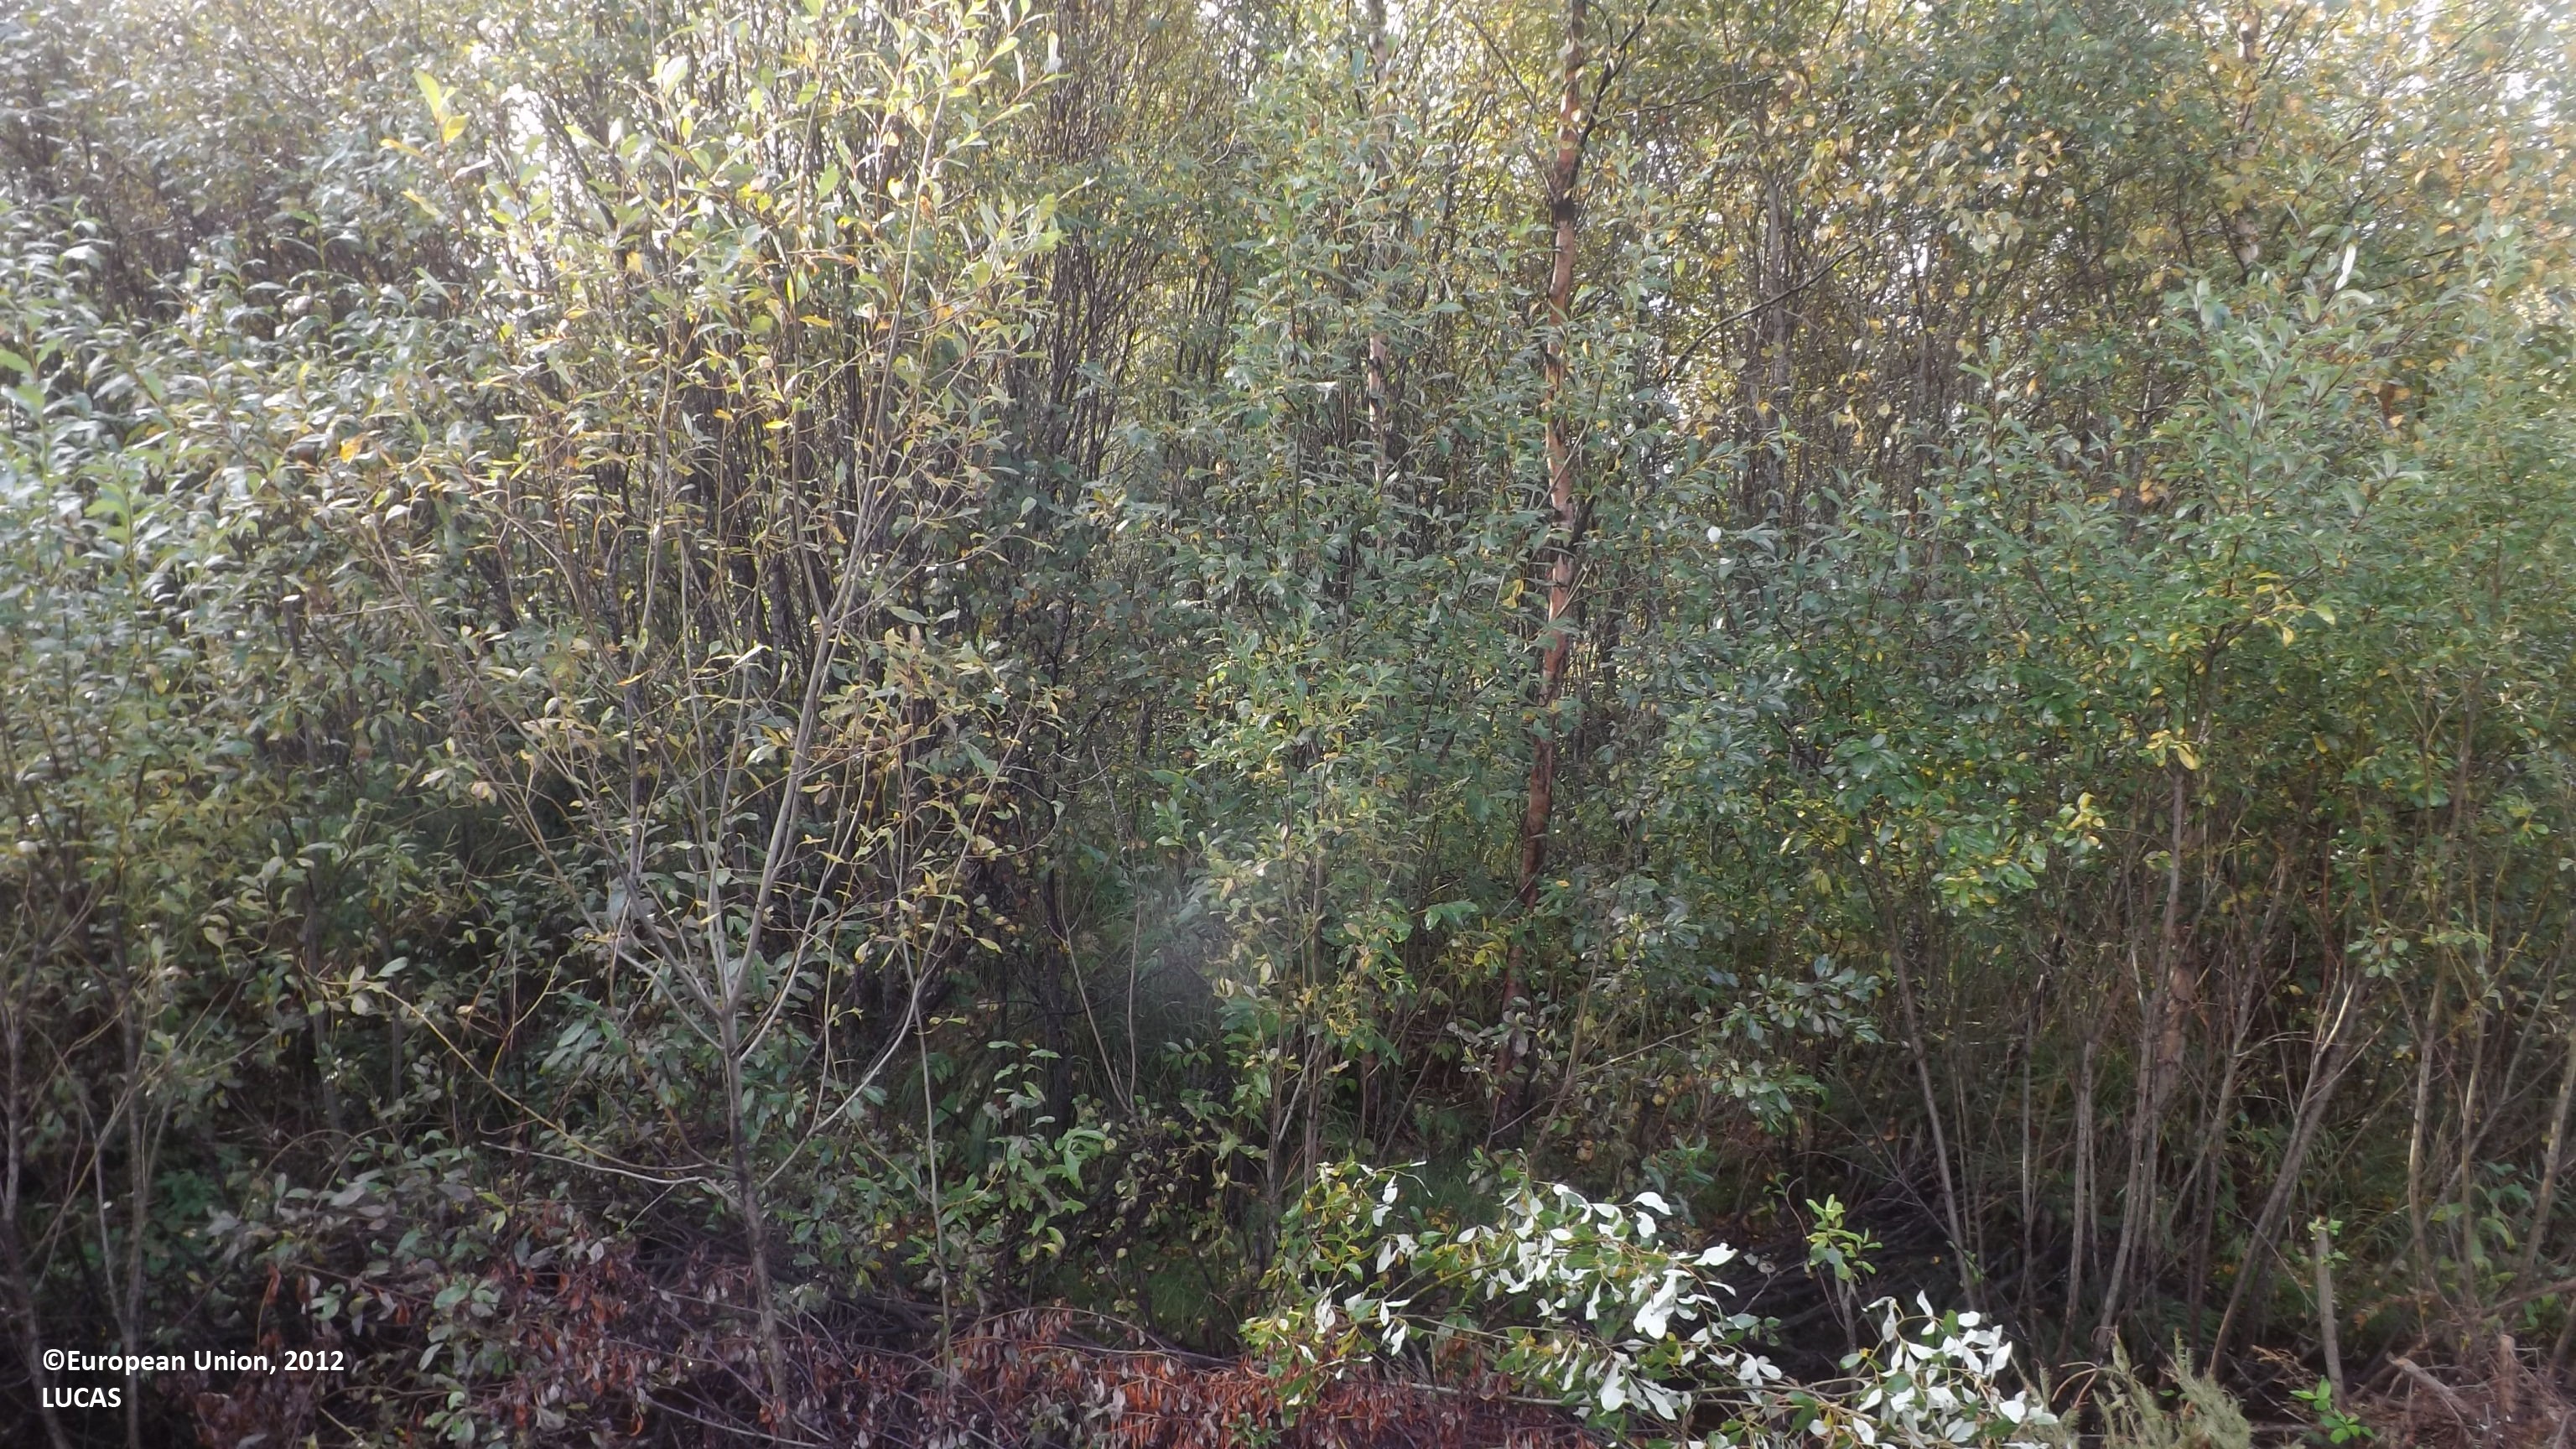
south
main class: Shrubland
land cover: Shrubland with sparse tree cover
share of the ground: > 75 %
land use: Semi-natural and natural areas not in use
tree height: > 5 m
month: August
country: FI
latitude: 63.8687
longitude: 23.5515
